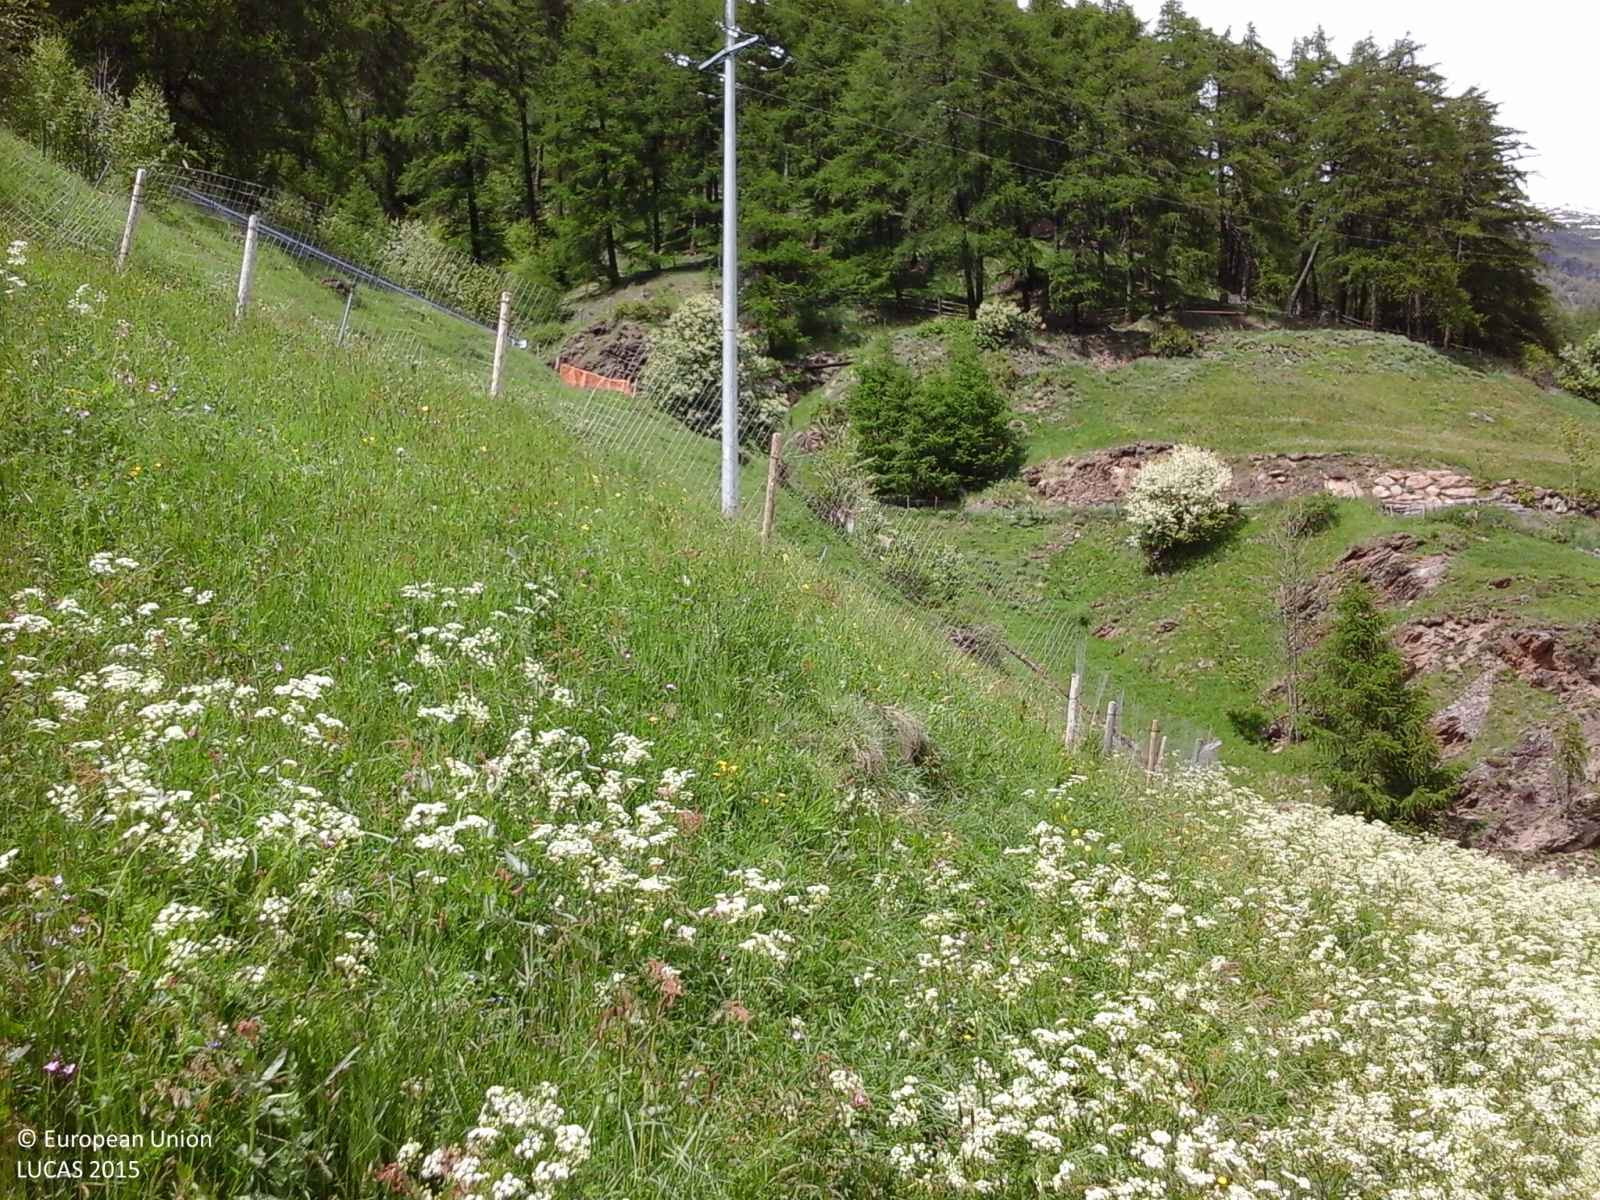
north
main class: Grassland
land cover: Grassland without tree/shrub cover
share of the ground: > 75 %
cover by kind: herbaceous plants 100 %
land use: Agriculture (excluding fallow land and kitchen gardens)
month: May
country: IT
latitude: 46.6917
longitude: 10.6138
